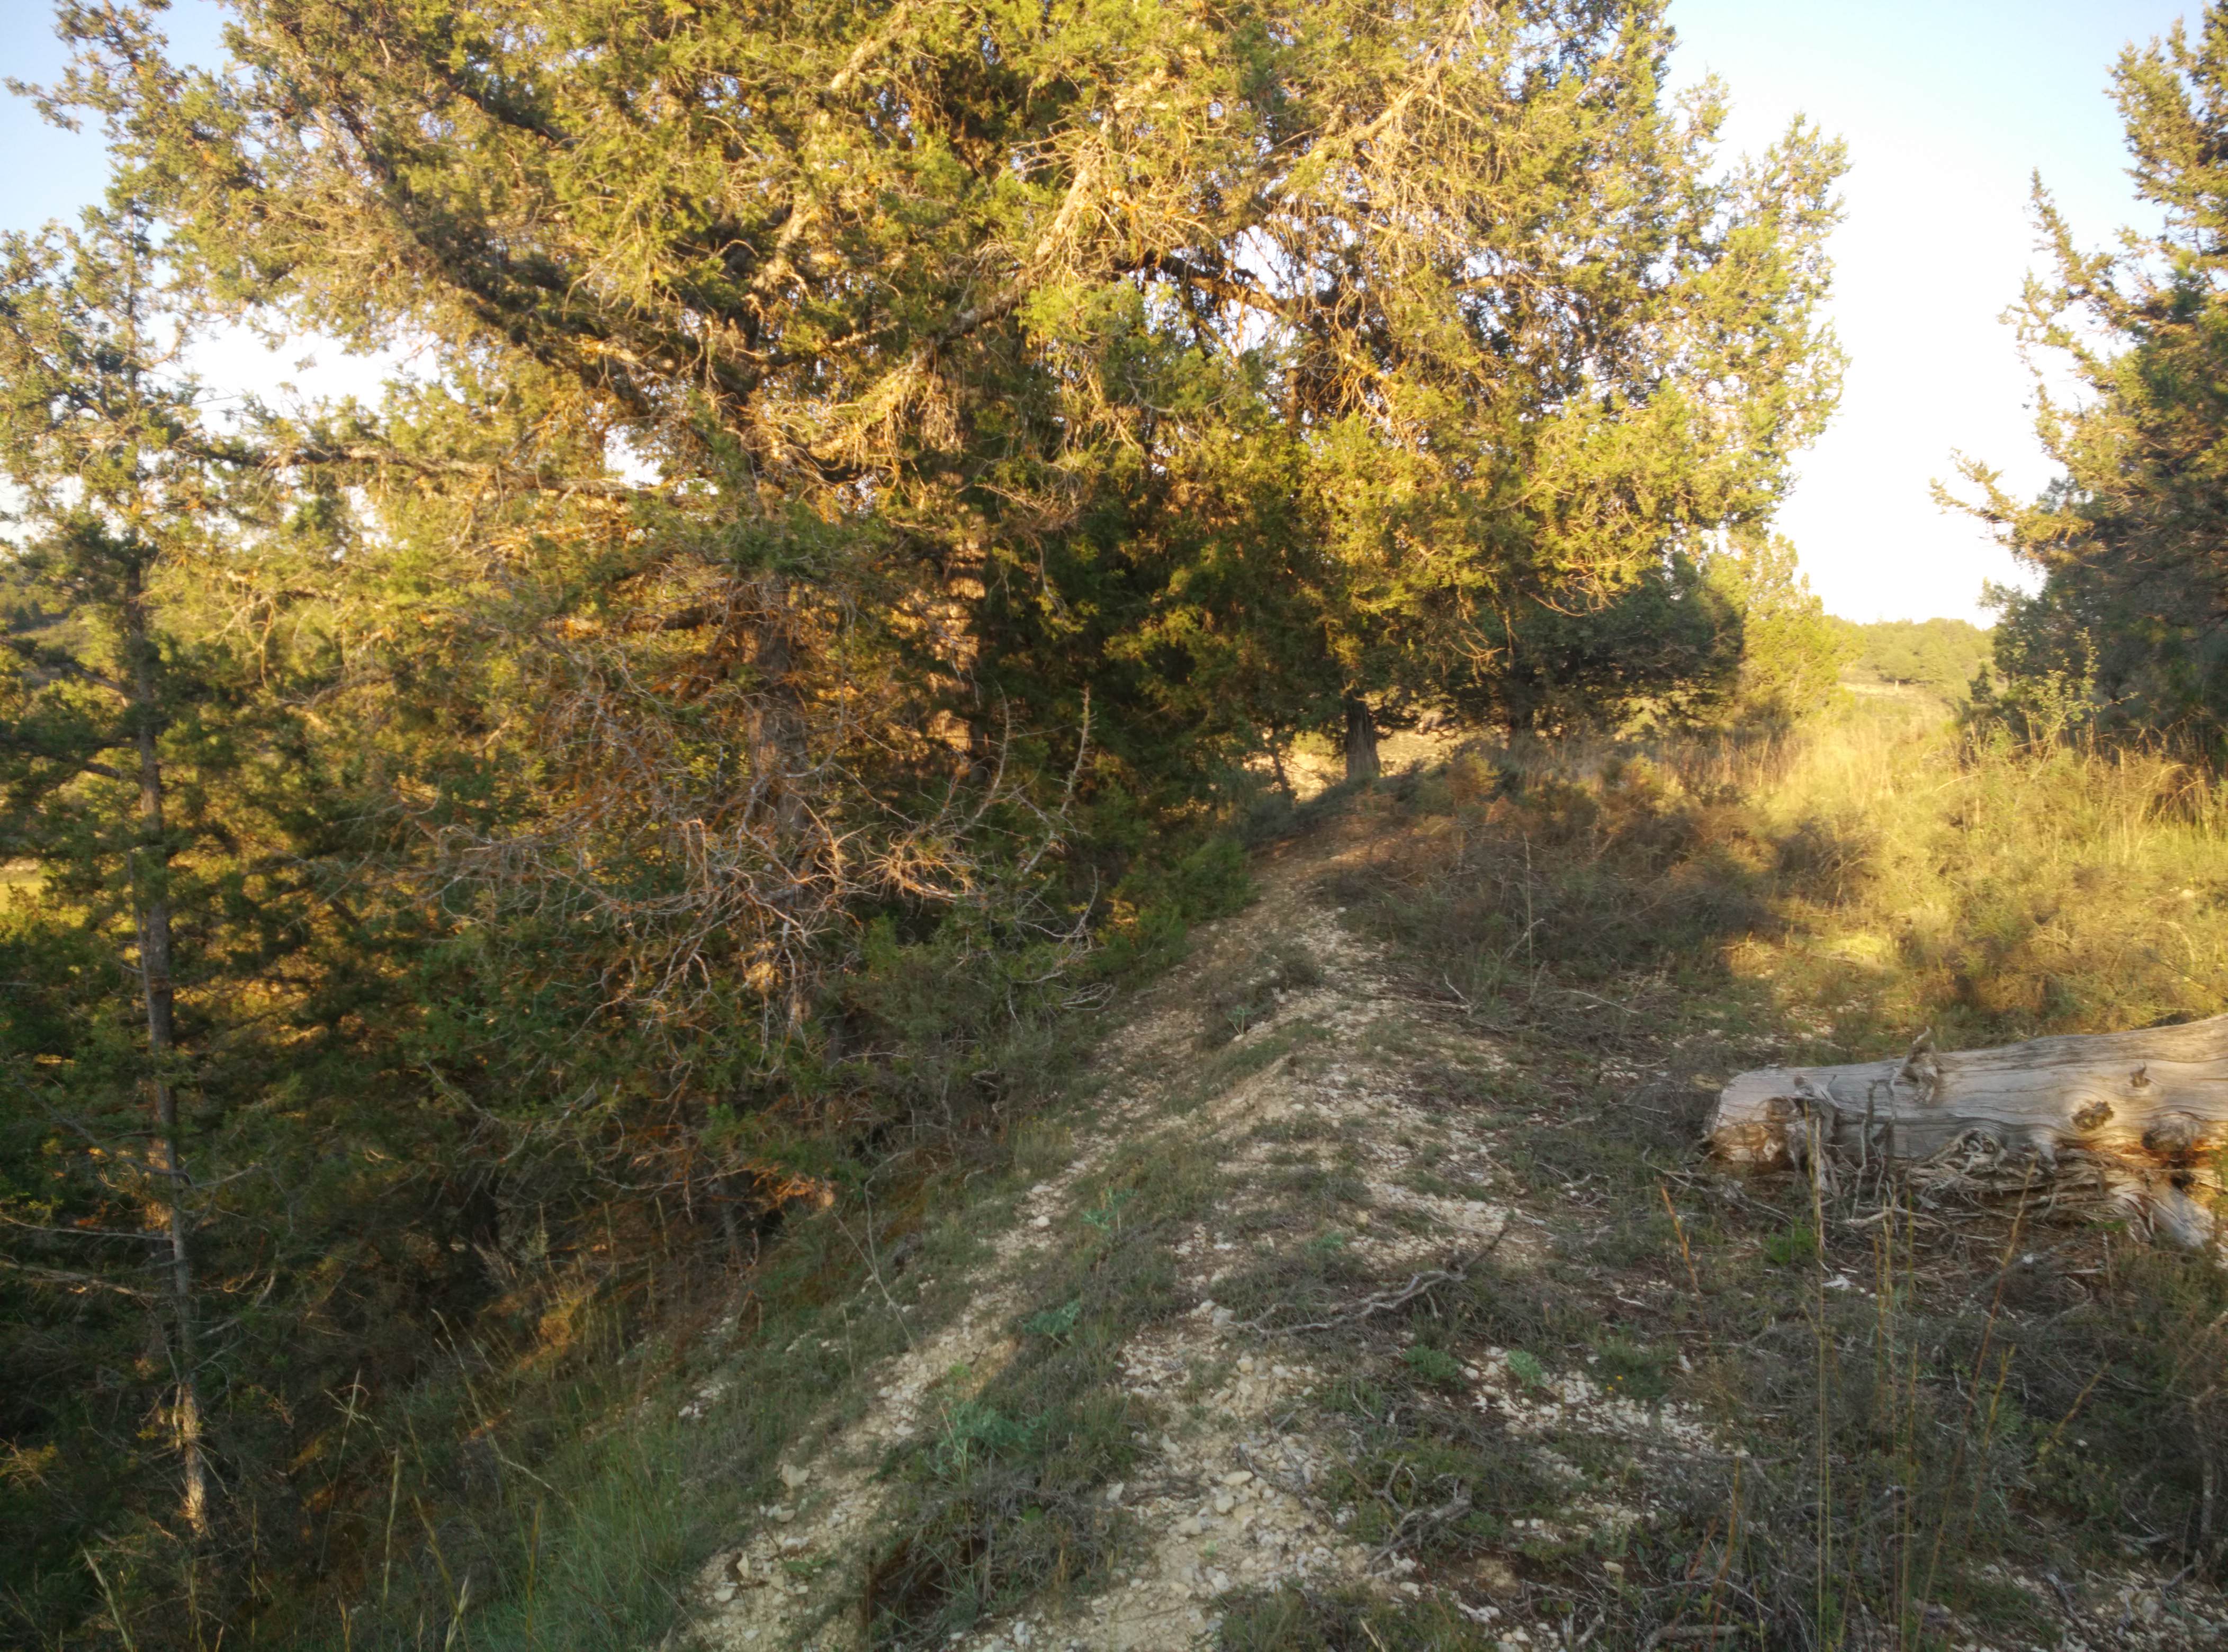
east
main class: Woodland
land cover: Other coniferous woodland
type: coniferous forest of the mediterranean region
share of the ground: 25 - 50 %
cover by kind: unconsolidated bare surface 50 %, coniferous forest trees 25 %, shrubs 15 %, herbaceous plants 10 %
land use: Semi-natural and natural areas not in use
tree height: > 5 m
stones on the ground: > 50 %
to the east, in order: Other coniferous woodland; Common wheat; Abandoned hedges; Common wheat; Grass margins; Common wheat; Grass margins; Common wheat; Grass margins; Common wheat
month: June
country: ES
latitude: 40.7671
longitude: -2.0235
